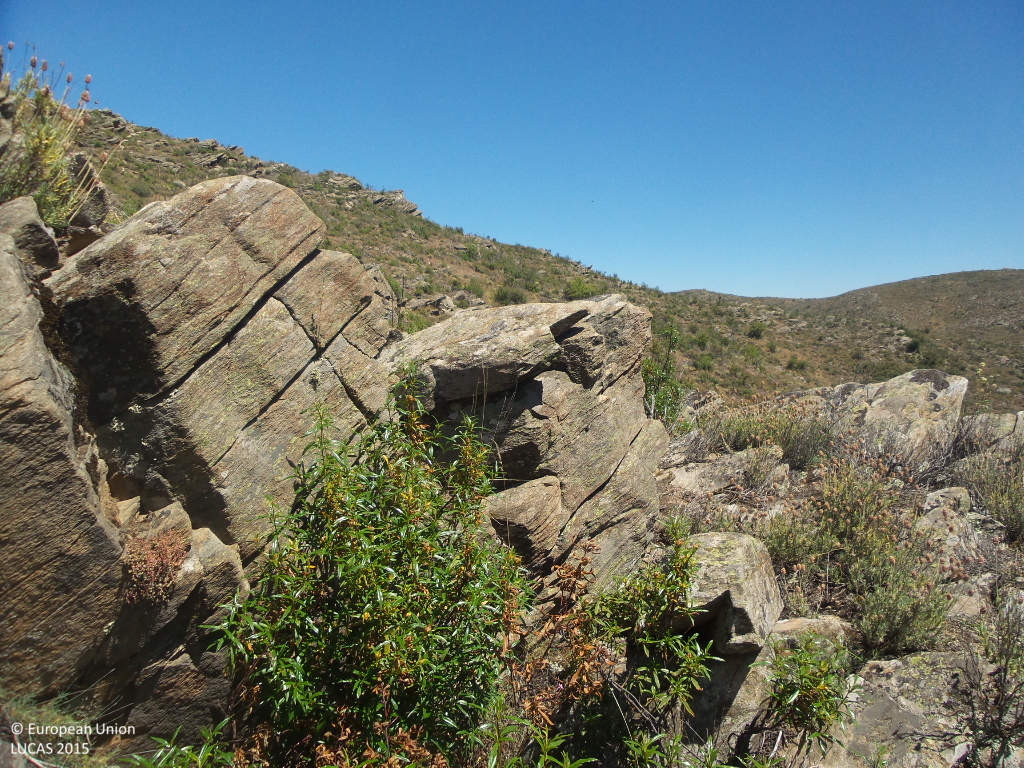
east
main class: Shrubland
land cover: Shrubland without tree cover
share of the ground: 10 - 25 %
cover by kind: consolidated bare surface 50 %, unconsolidated bare surface 30 %, shrubs 20 %
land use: Semi-natural and natural areas not in use
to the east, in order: Shrubland without tree cover
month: June
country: ES
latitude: 41.1293
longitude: -2.9129
